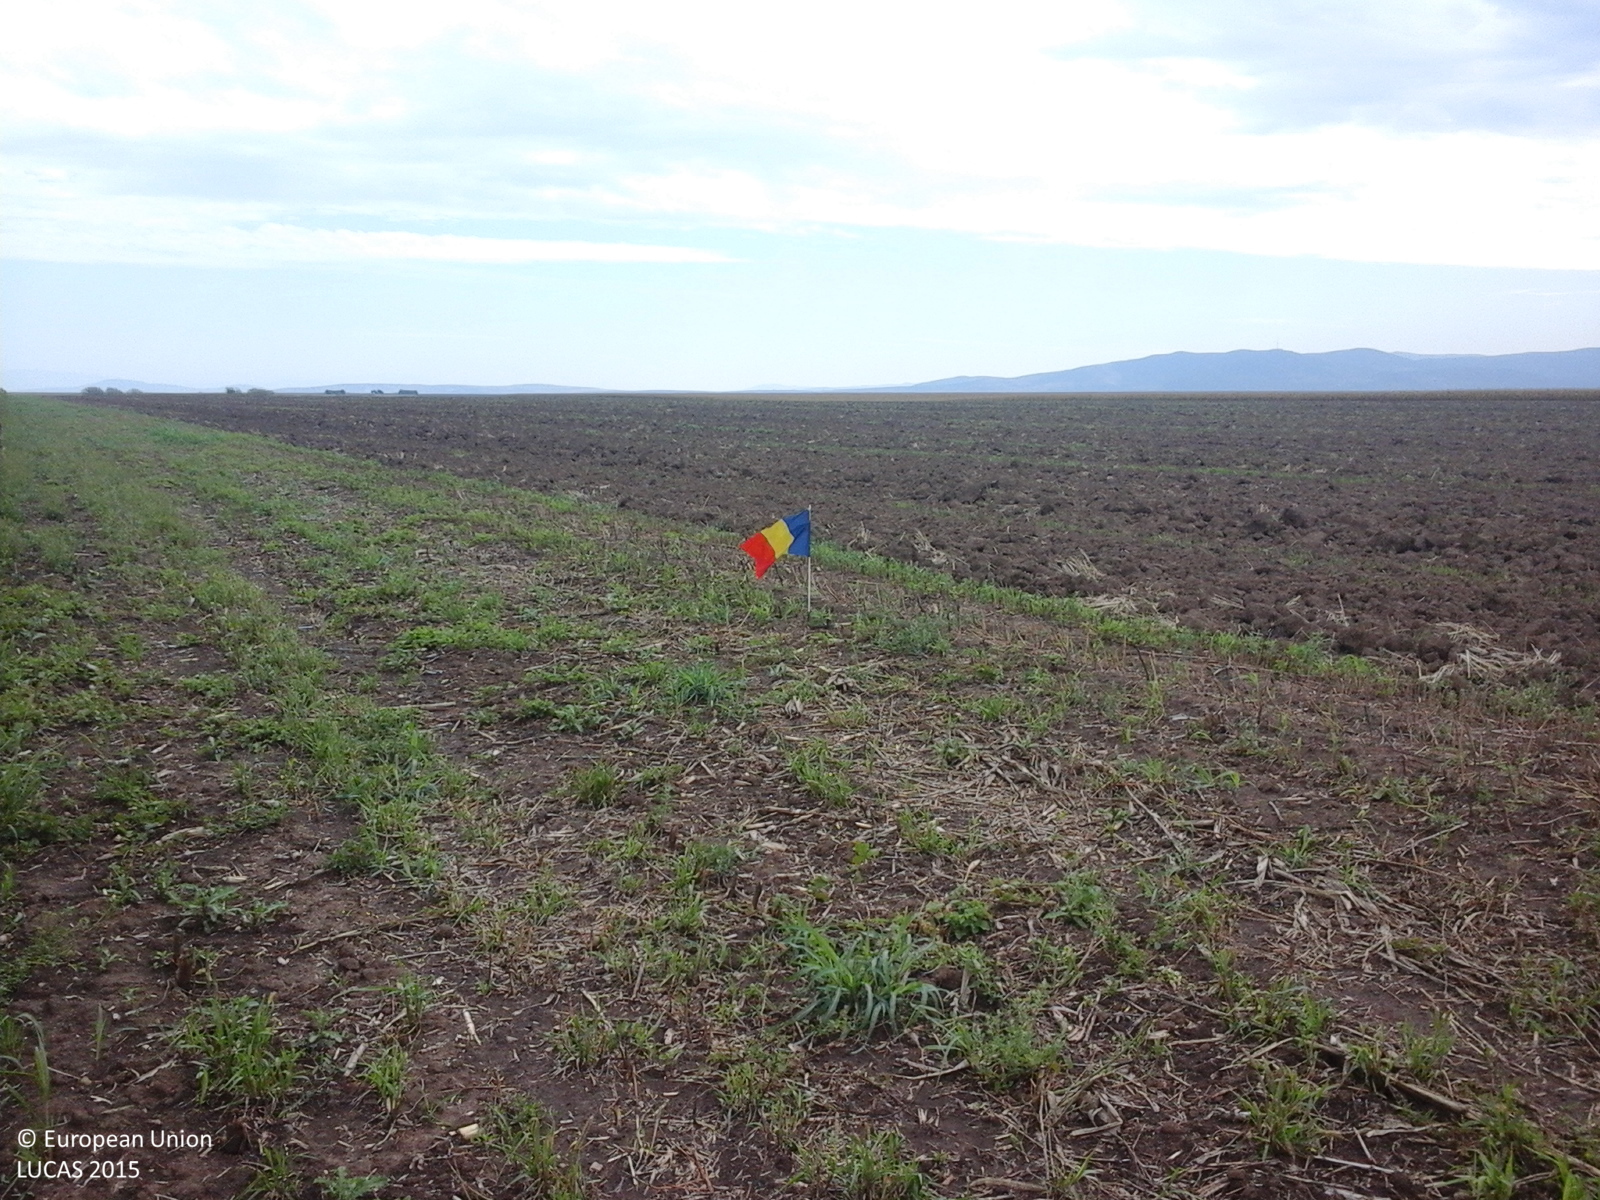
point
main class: Cropland
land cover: Maize
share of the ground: < 10 %
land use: Agriculture (excluding fallow land and kitchen gardens)
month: August
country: RO
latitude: 46.3103
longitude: 21.5028
